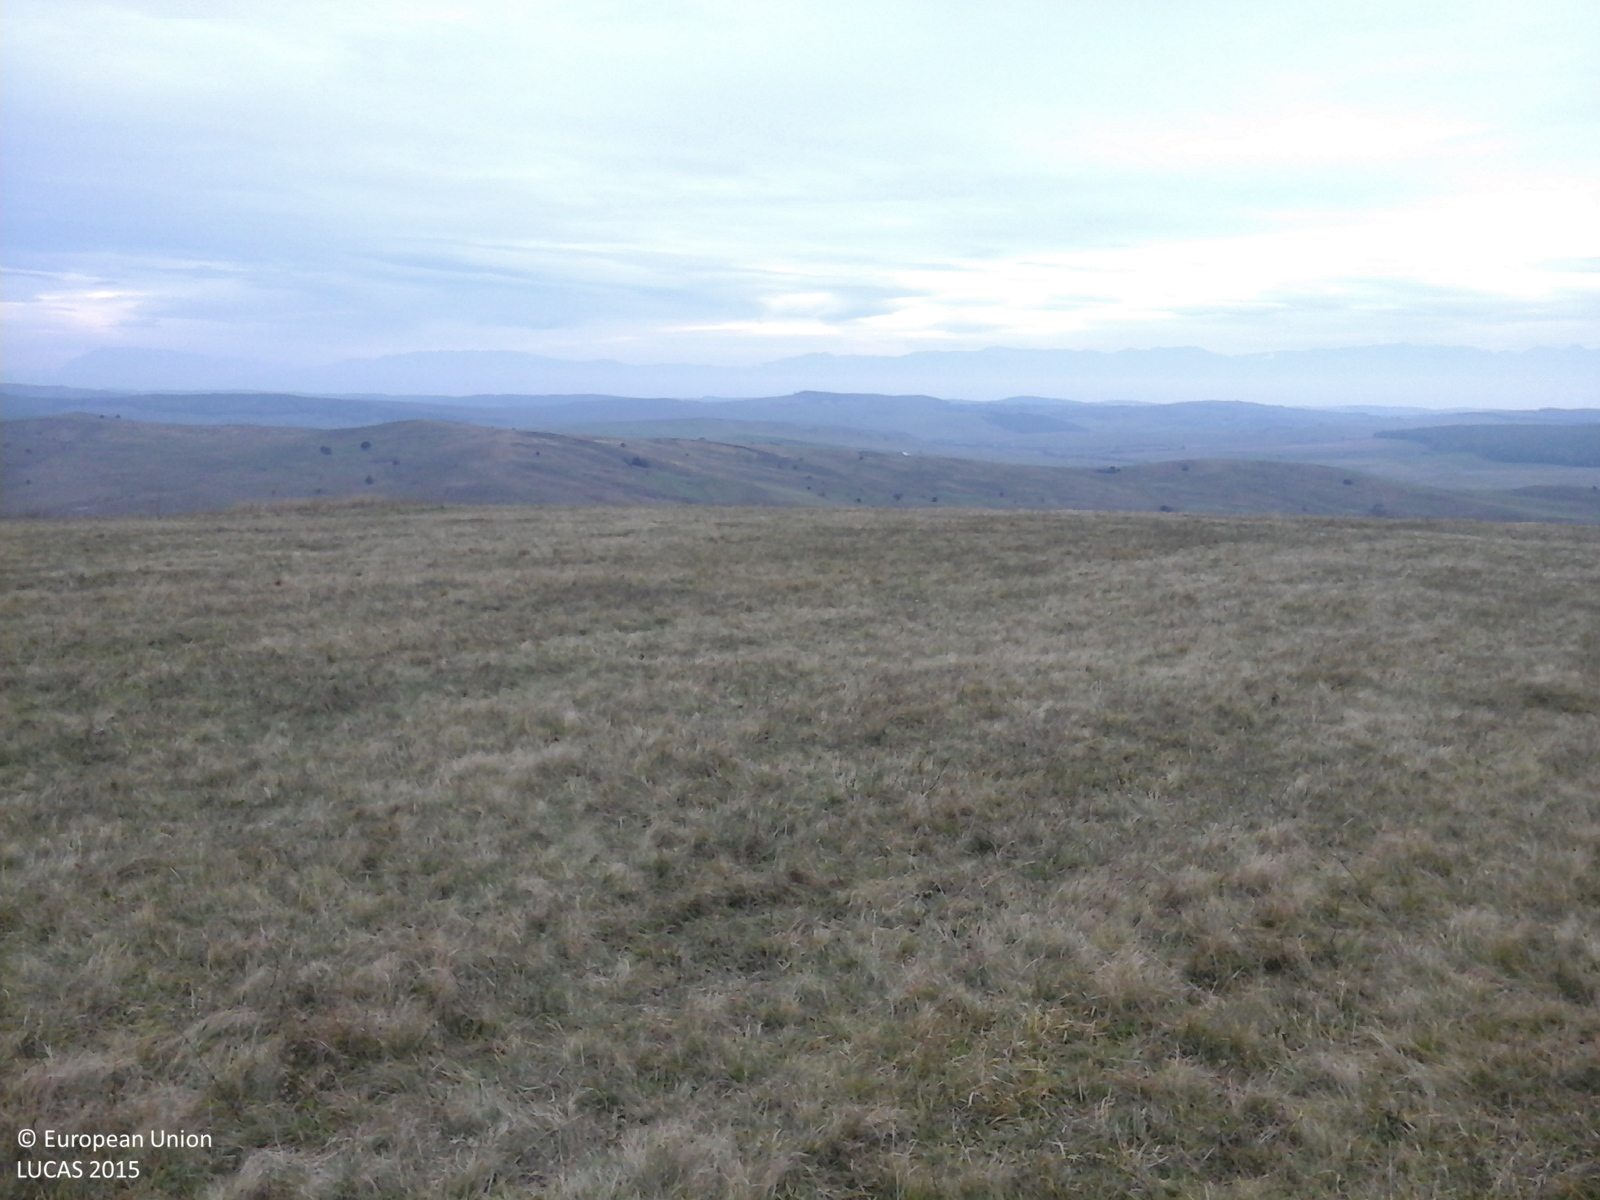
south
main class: Grassland
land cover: Grassland without tree/shrub cover
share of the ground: > 75 %
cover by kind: herbaceous plants 100 %
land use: Agriculture (excluding fallow land and kitchen gardens)
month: October
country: RO
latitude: 46.0377
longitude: 24.9920
